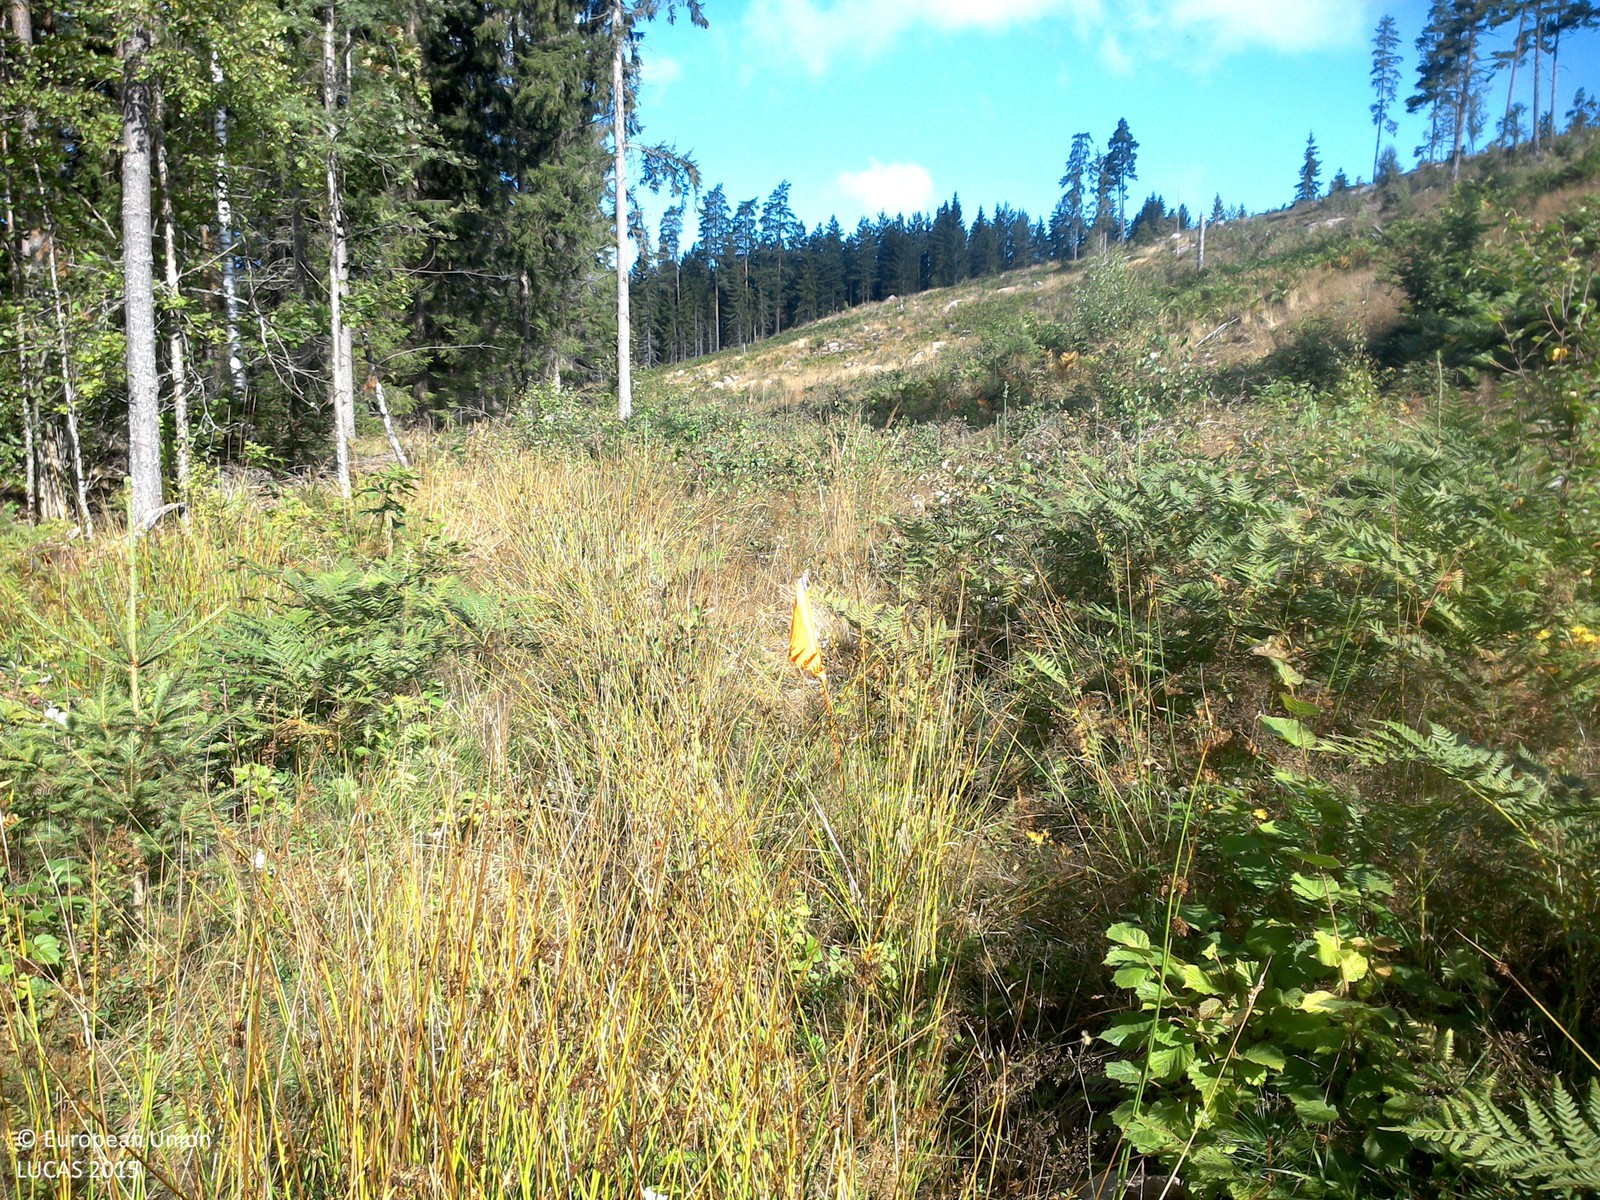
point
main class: Shrubland
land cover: Shrubland with sparse tree cover
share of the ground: 50 - 75 %
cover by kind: shrubs 55 %, herbaceous plants 40 %, broadleaved forest trees 5 %
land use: Forestry
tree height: < 5 m
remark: Clear cut
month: August
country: SE
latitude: 58.0390
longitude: 15.3984
